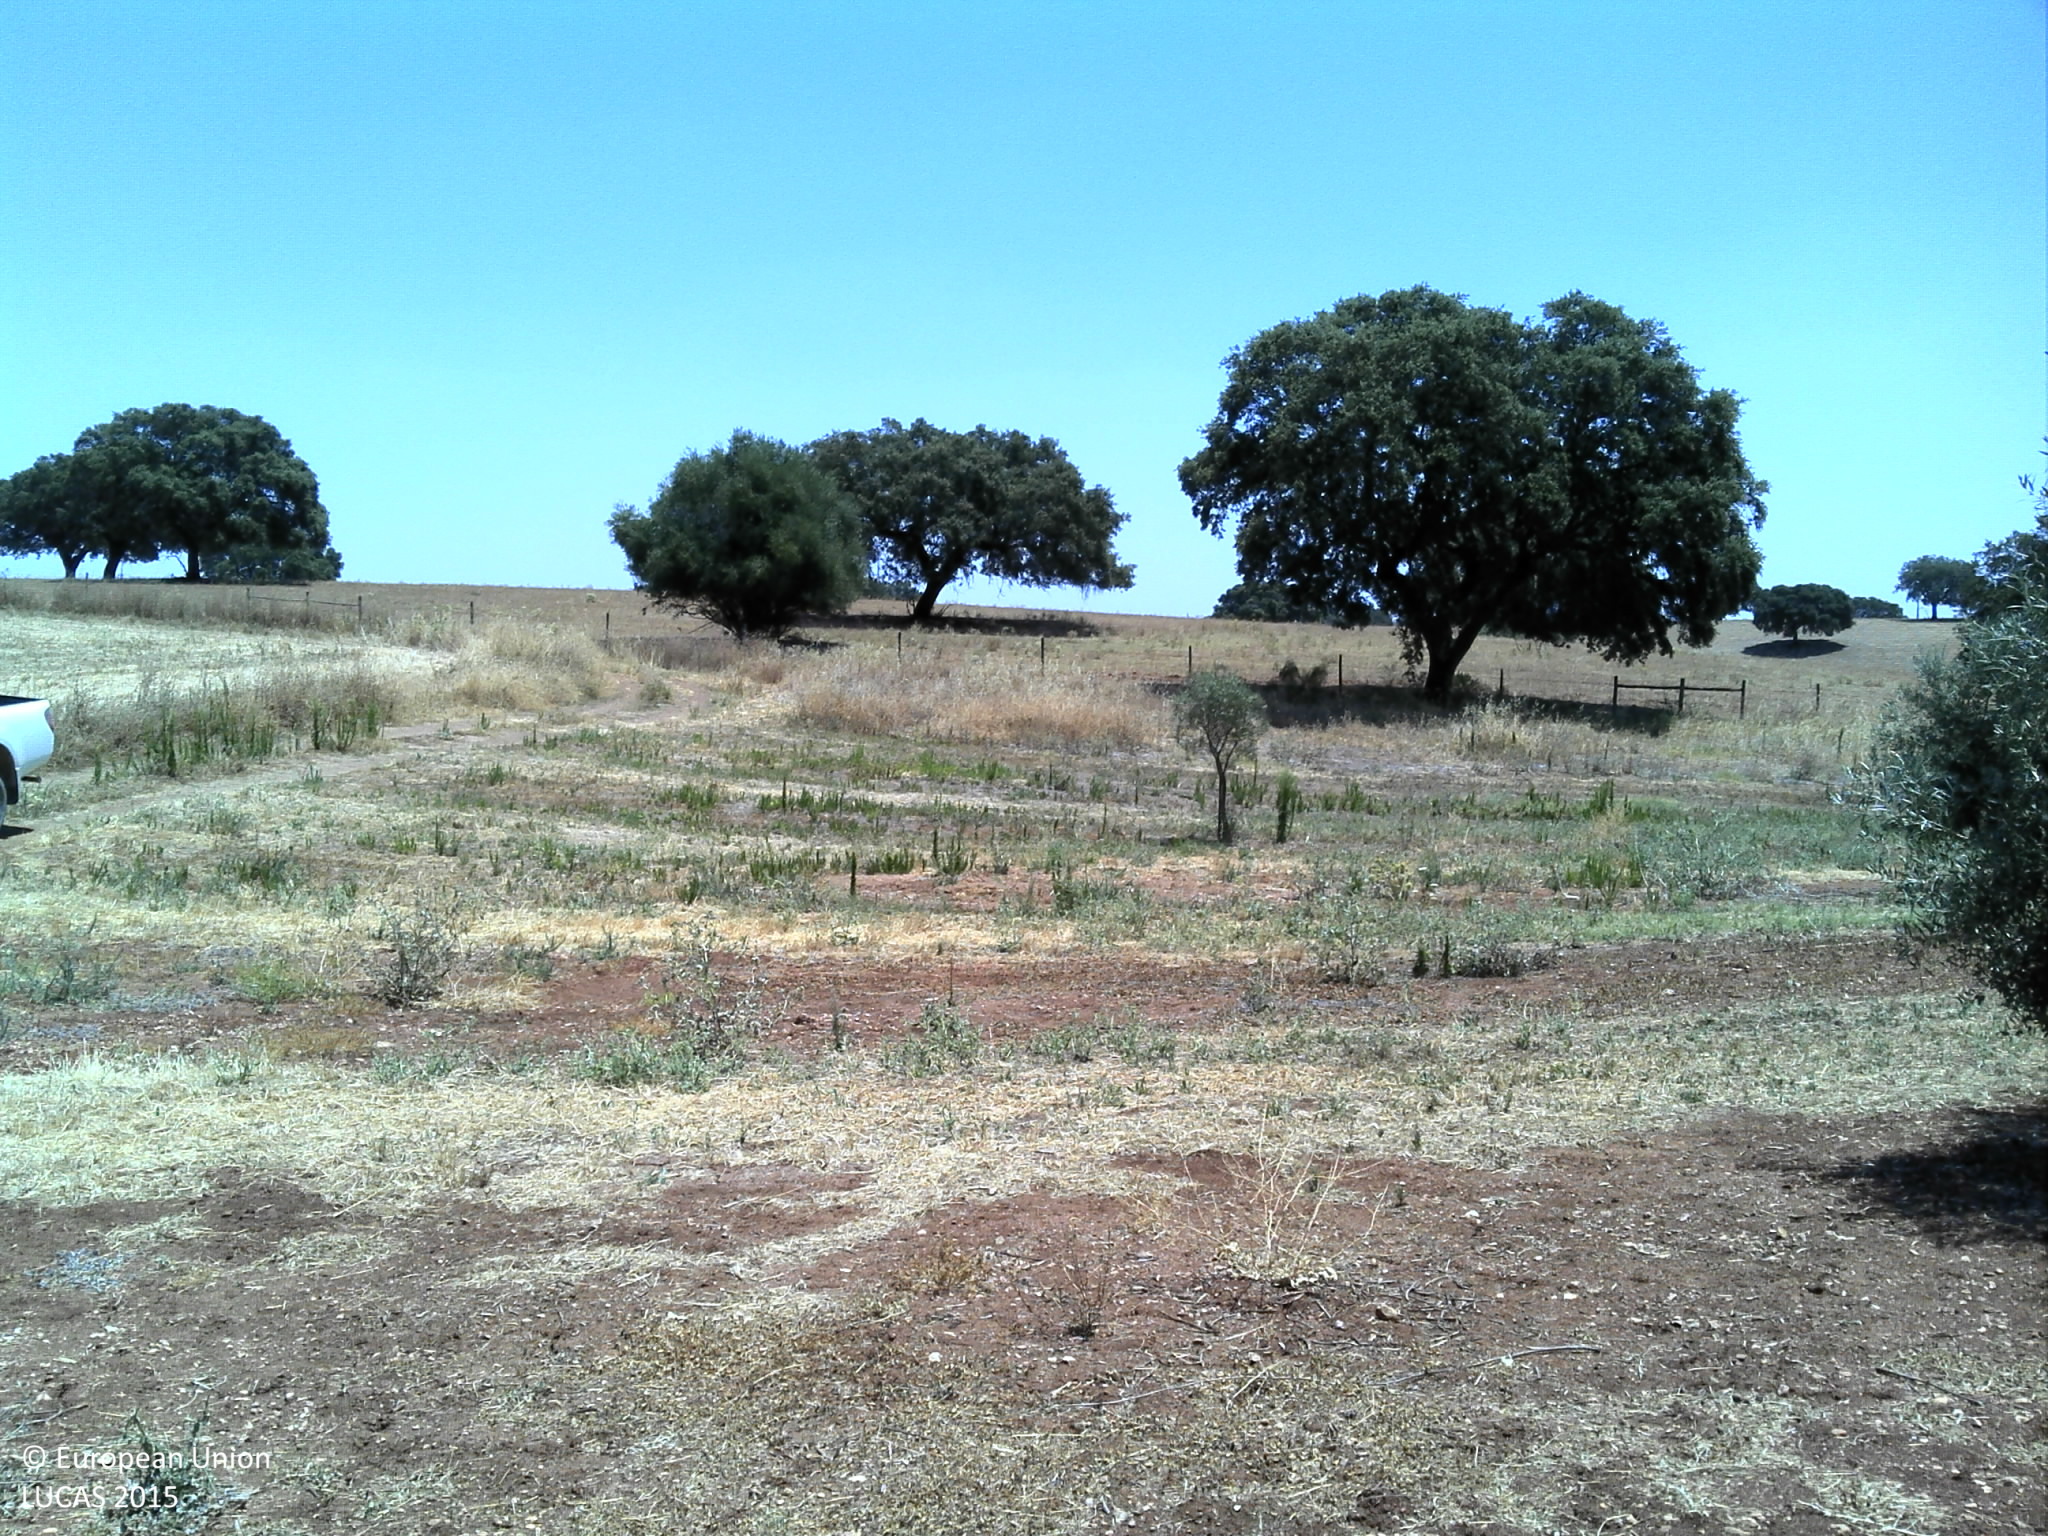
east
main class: Cropland
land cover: Olive groves
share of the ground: 25 - 50 %
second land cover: Grassland without tree/shrub cover
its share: 10 - 25 %
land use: Agriculture (excluding fallow land and kitchen gardens)
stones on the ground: < 10 %
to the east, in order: Olive groves; Grassland without tree/shrub cover; Olive groves; Grassland without tree/shrub cover; Fences; Grassland with sparse tree/shrub cover; Grassland without tree/shrub cover; Single bushes/trees; Grassland without tree/shrub cover
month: June
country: PT
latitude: 38.0201
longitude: -7.5748
